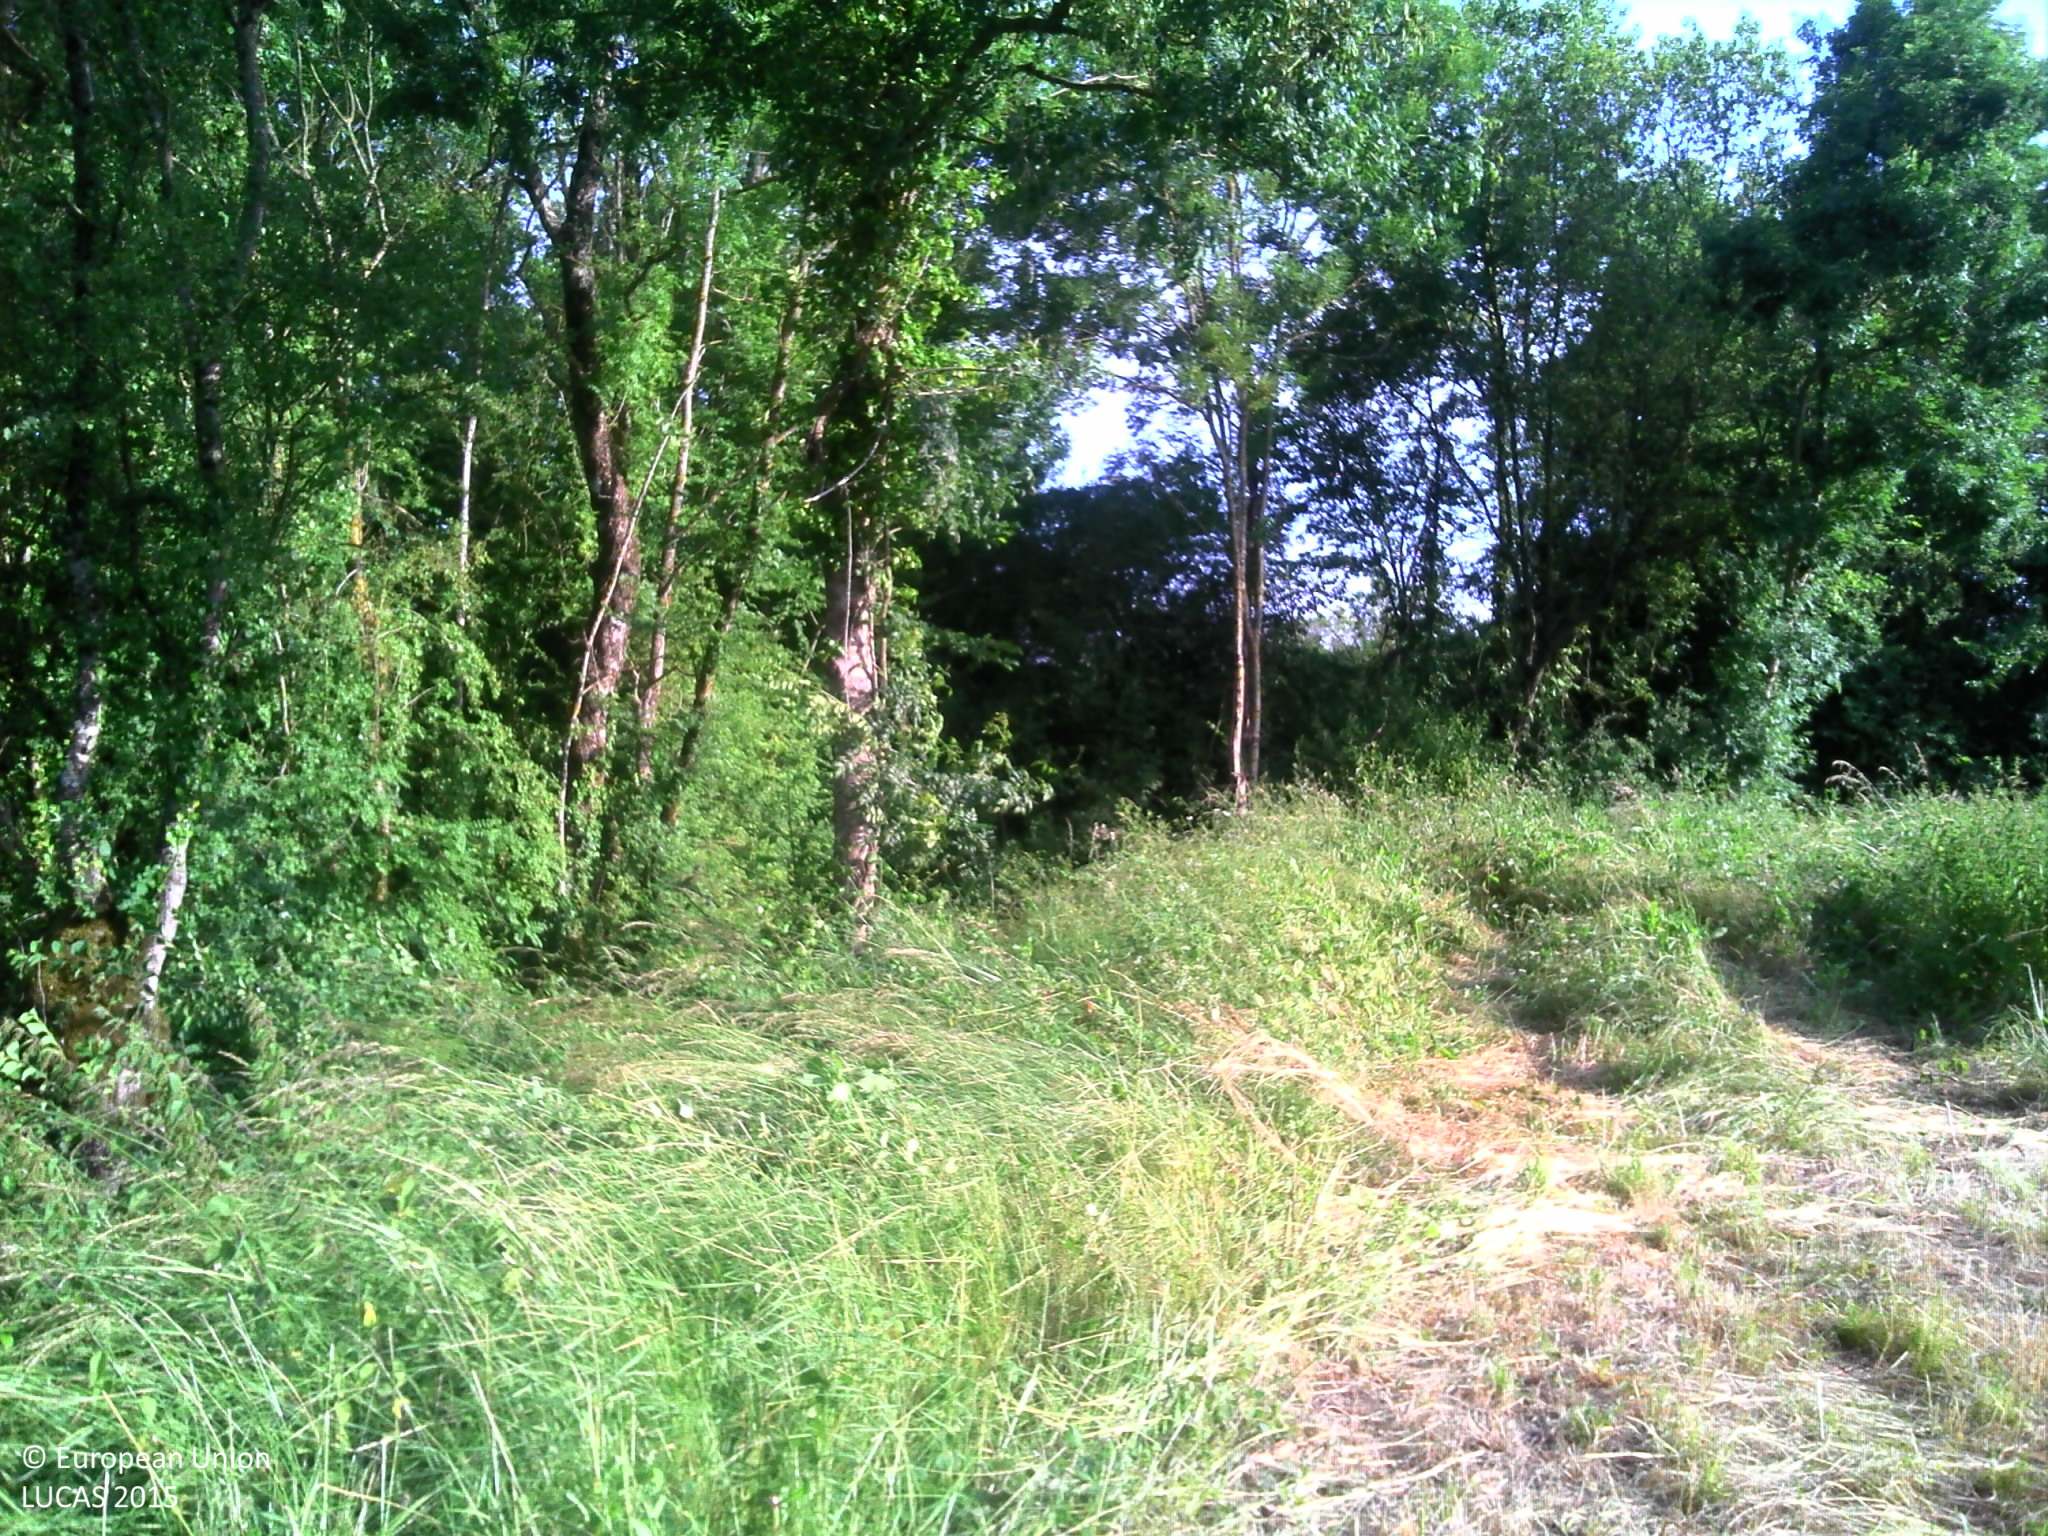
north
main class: Grassland
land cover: Grassland without tree/shrub cover
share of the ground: > 75 %
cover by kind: herbaceous plants 100 %
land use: Agriculture (excluding fallow land and kitchen gardens)
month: June
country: FR
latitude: 46.0418
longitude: -0.9482
